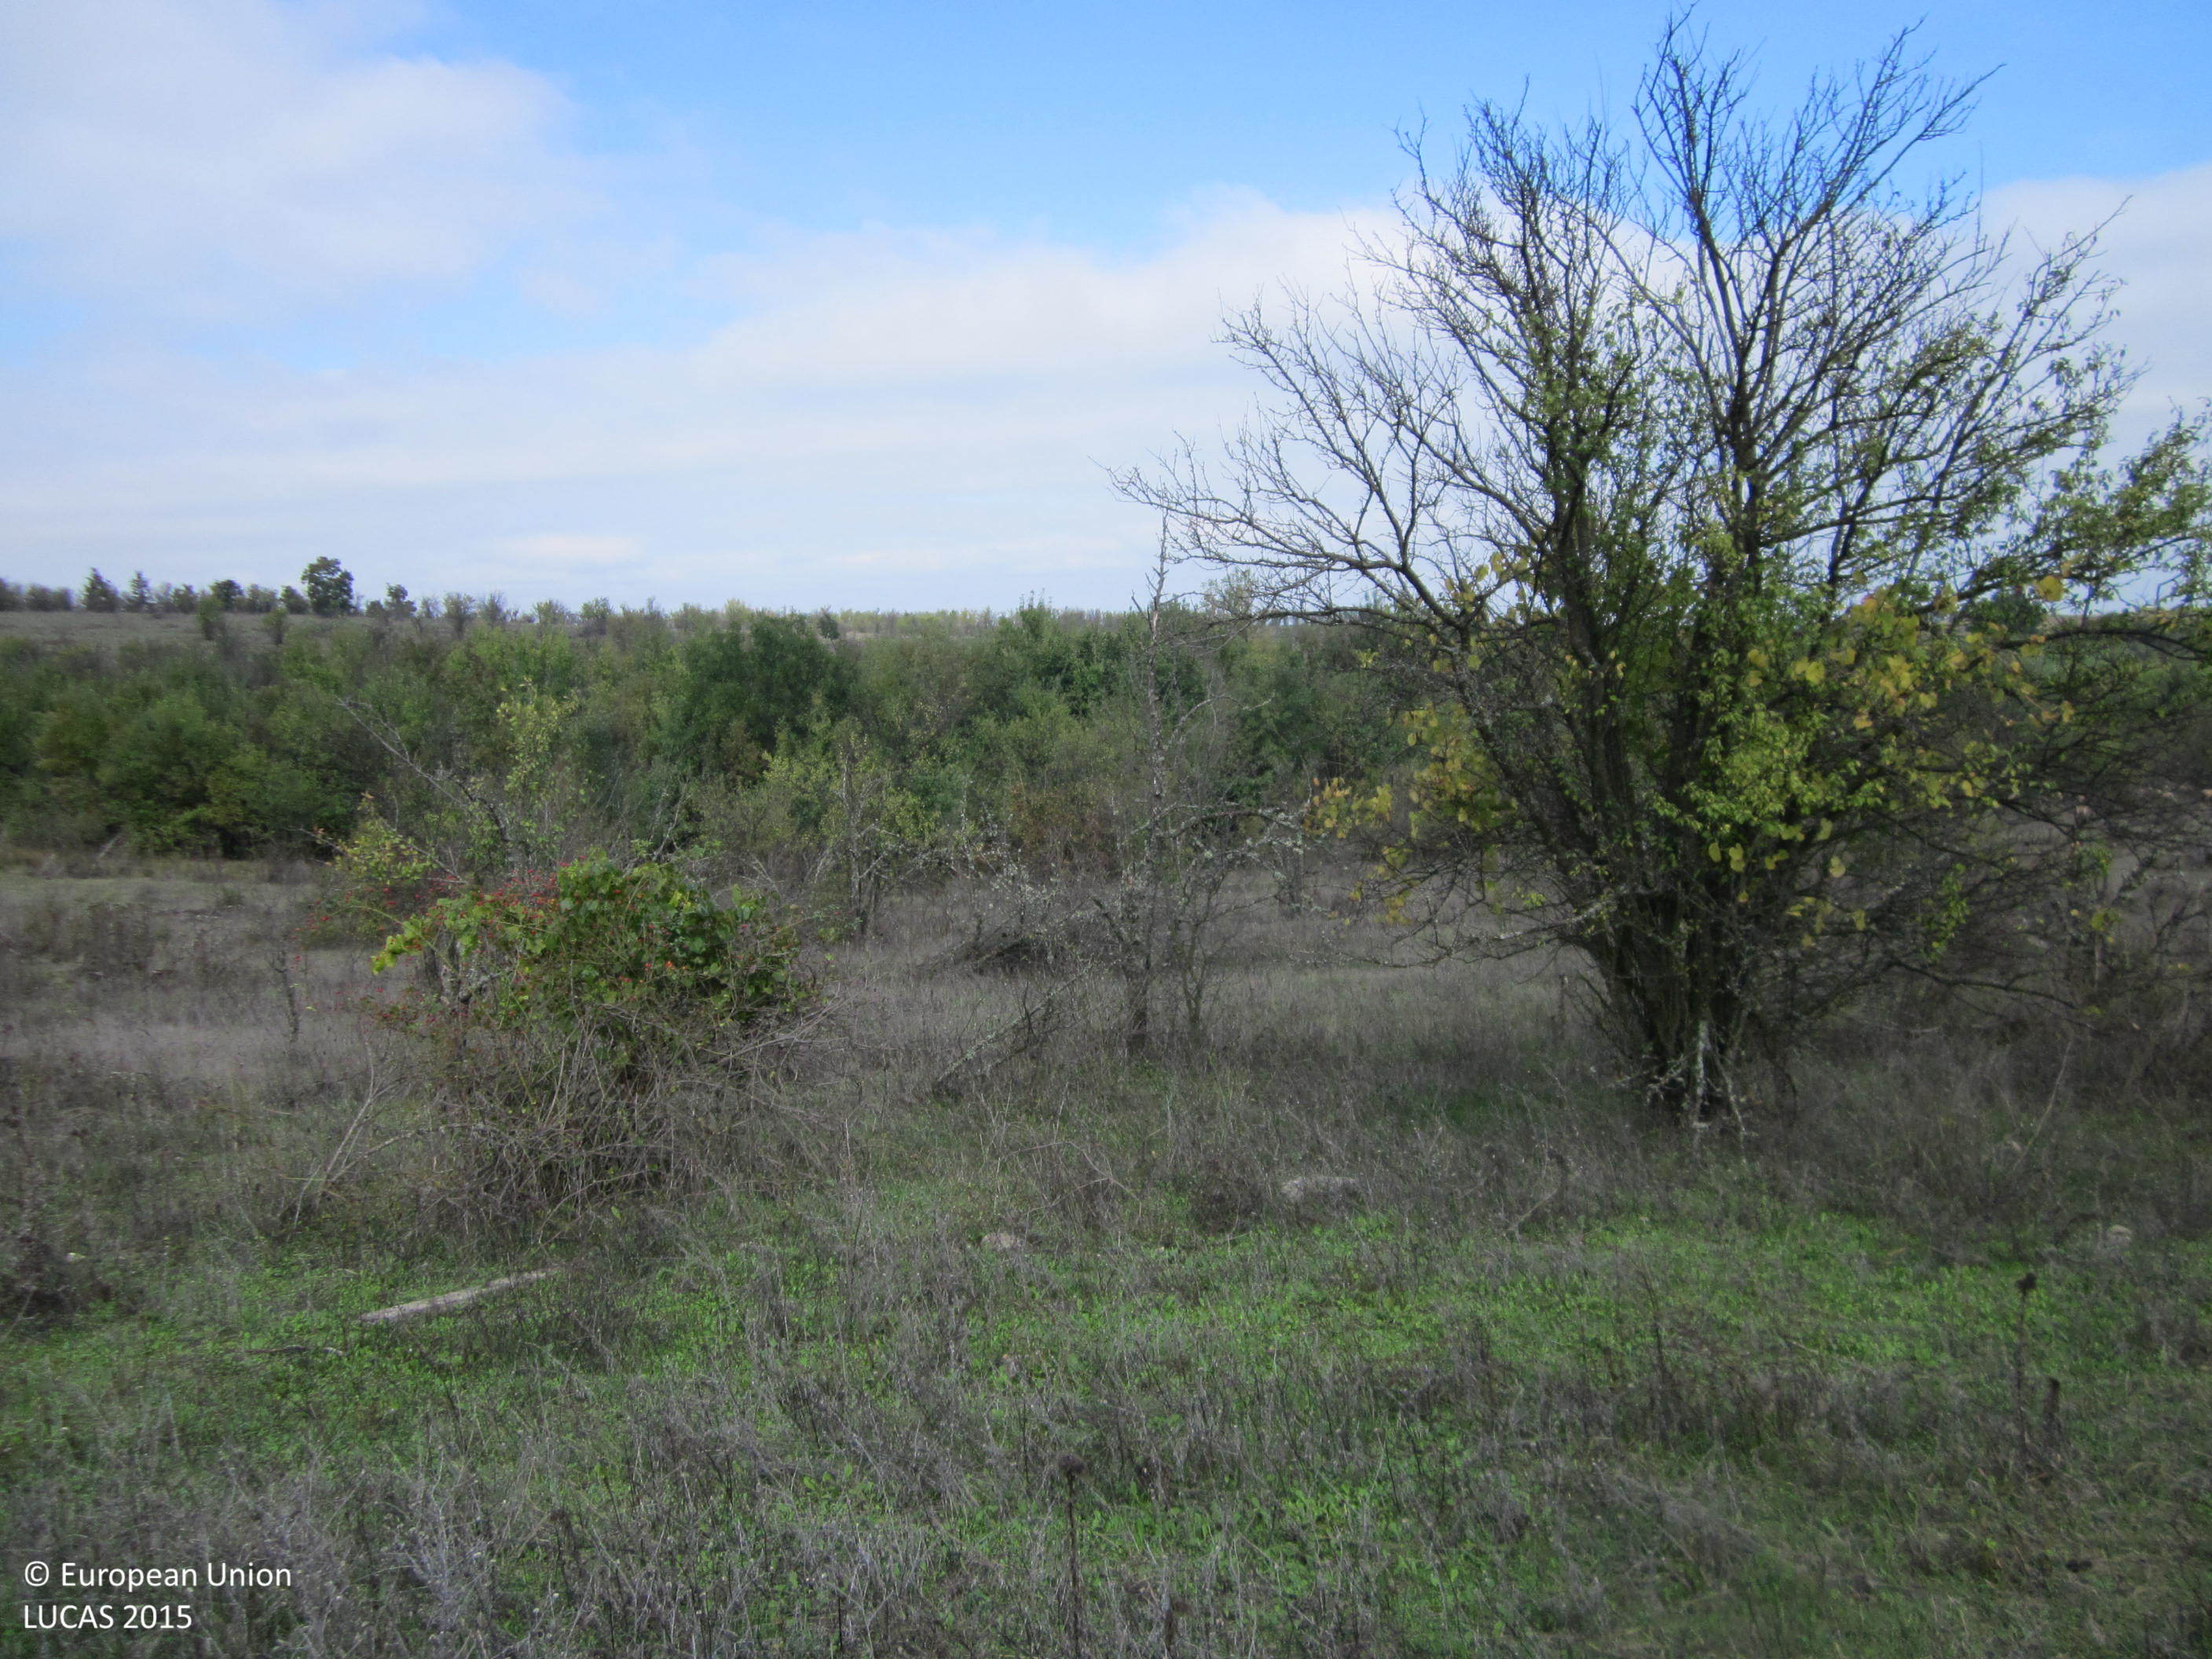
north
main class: Shrubland
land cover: Shrubland with sparse tree cover
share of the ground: > 75 %
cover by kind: shrubs 80 %, herbaceous plants 15 %, broadleaved forest trees 5 %
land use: Semi-natural and natural areas not in use
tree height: < 5 m
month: October
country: BG
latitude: 42.3291
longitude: 27.2066
